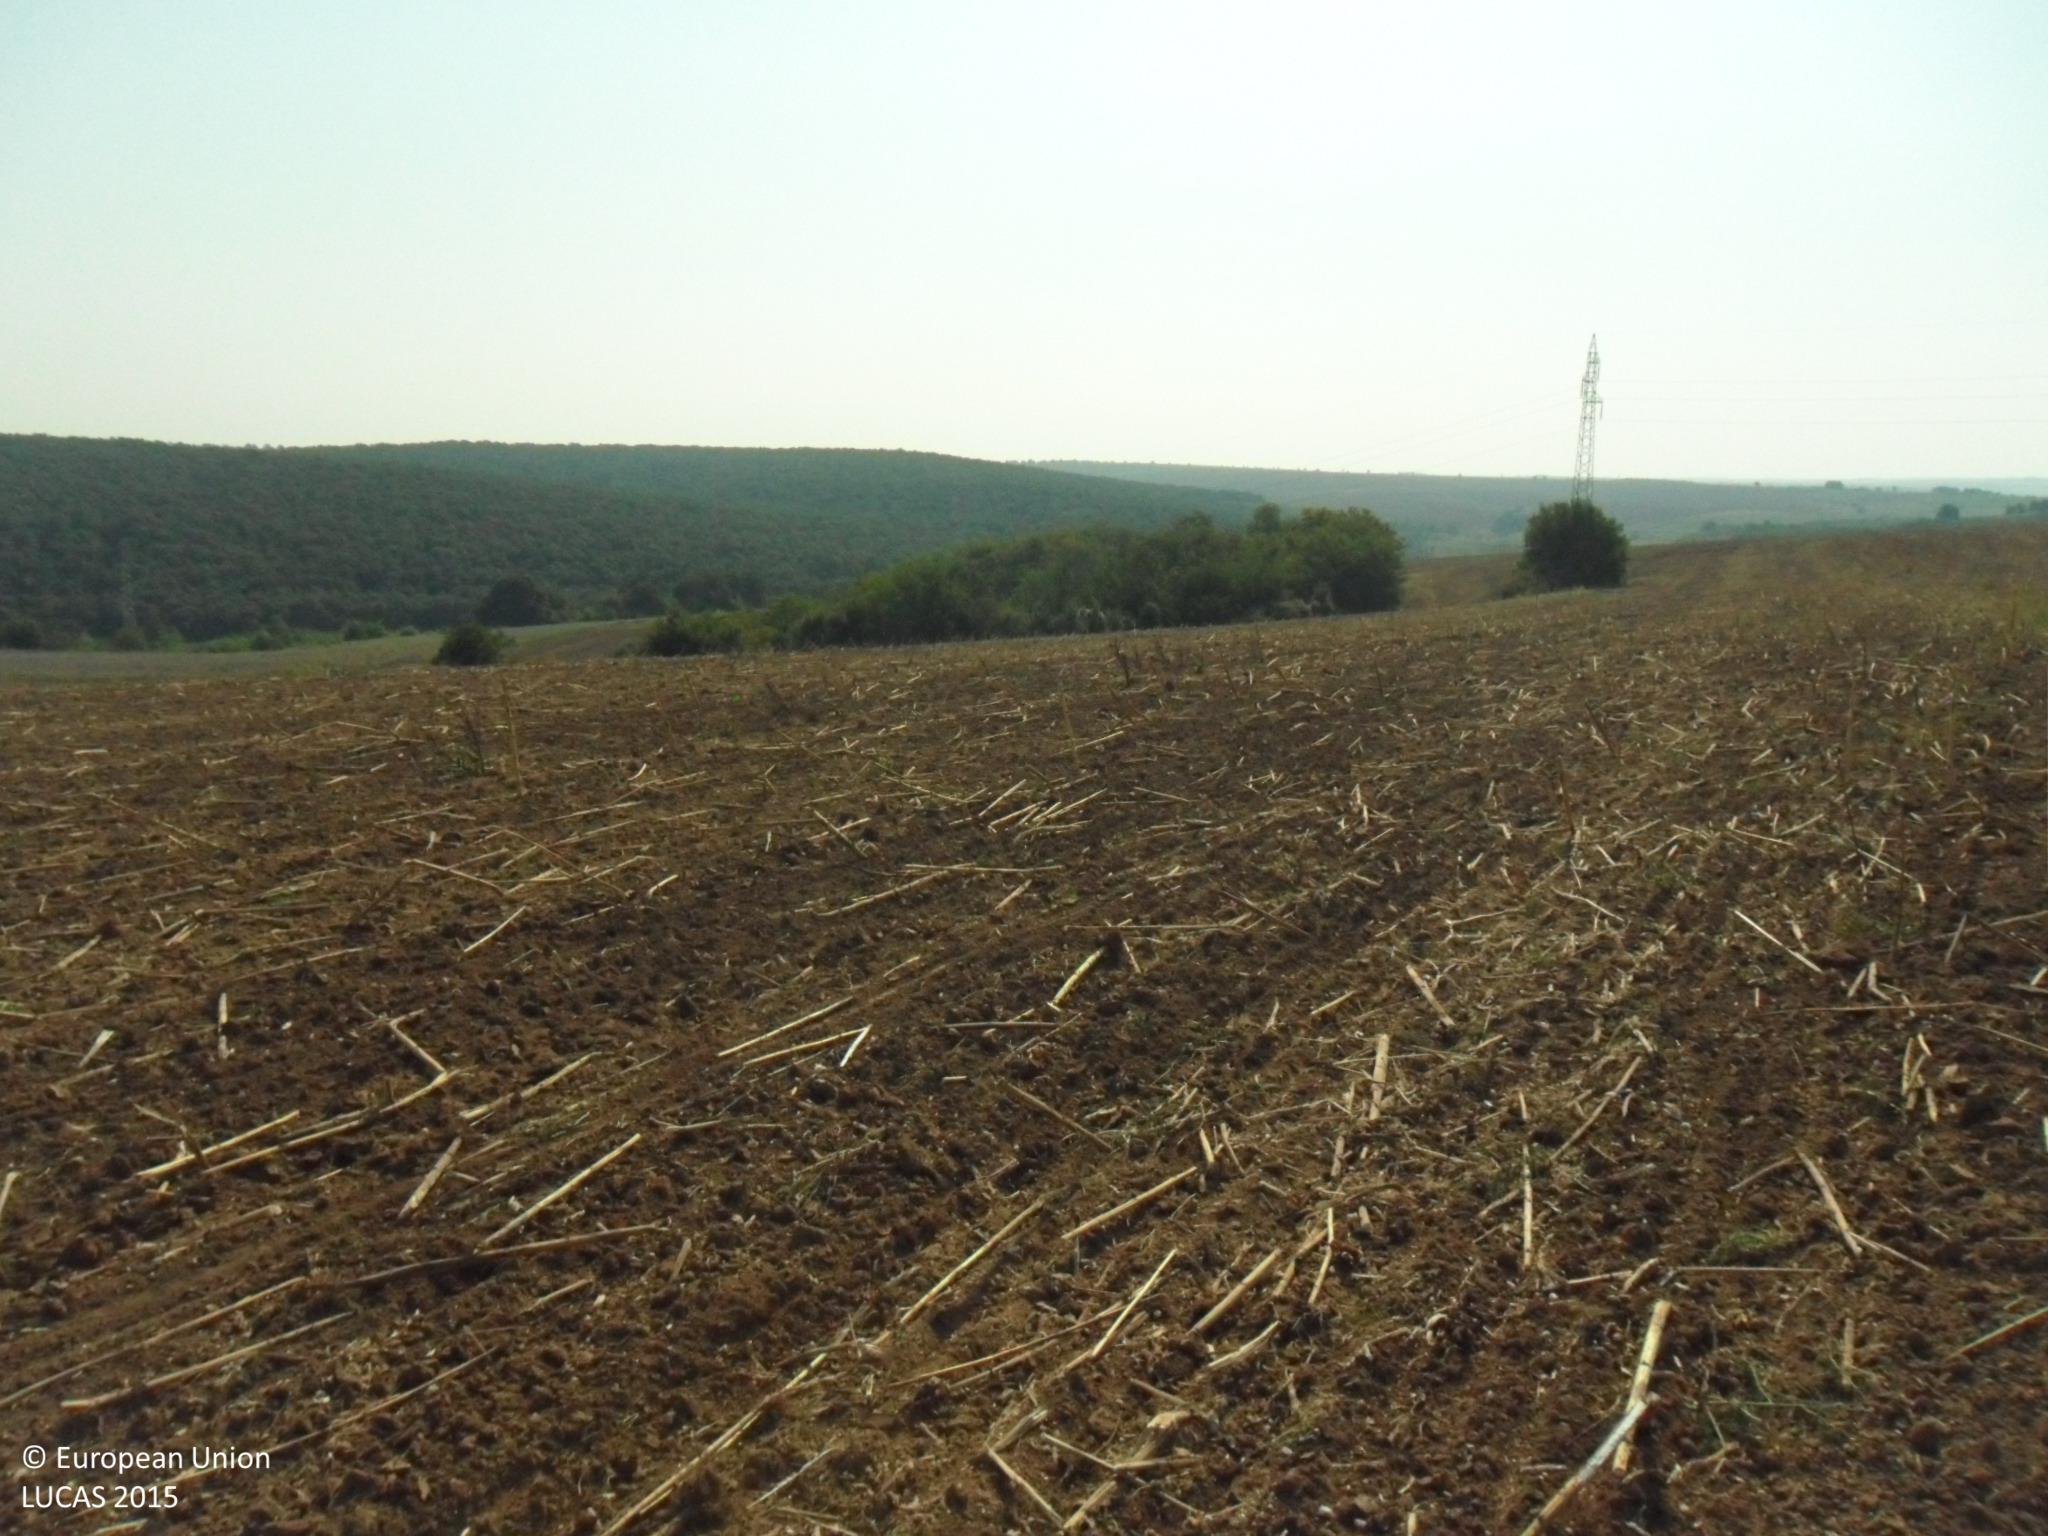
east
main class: Cropland
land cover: Sunflower
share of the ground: < 10 %
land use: Agriculture (excluding fallow land and kitchen gardens)
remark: Harvested field
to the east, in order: Sunflower; Grass margins; Grassland with sparse tree/shrub cover; Shrubland without tree cover; Tracks; Grass margins; Sunflower; Electric lines; Sunflower
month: September
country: BG
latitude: 43.6367
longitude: 26.2006
